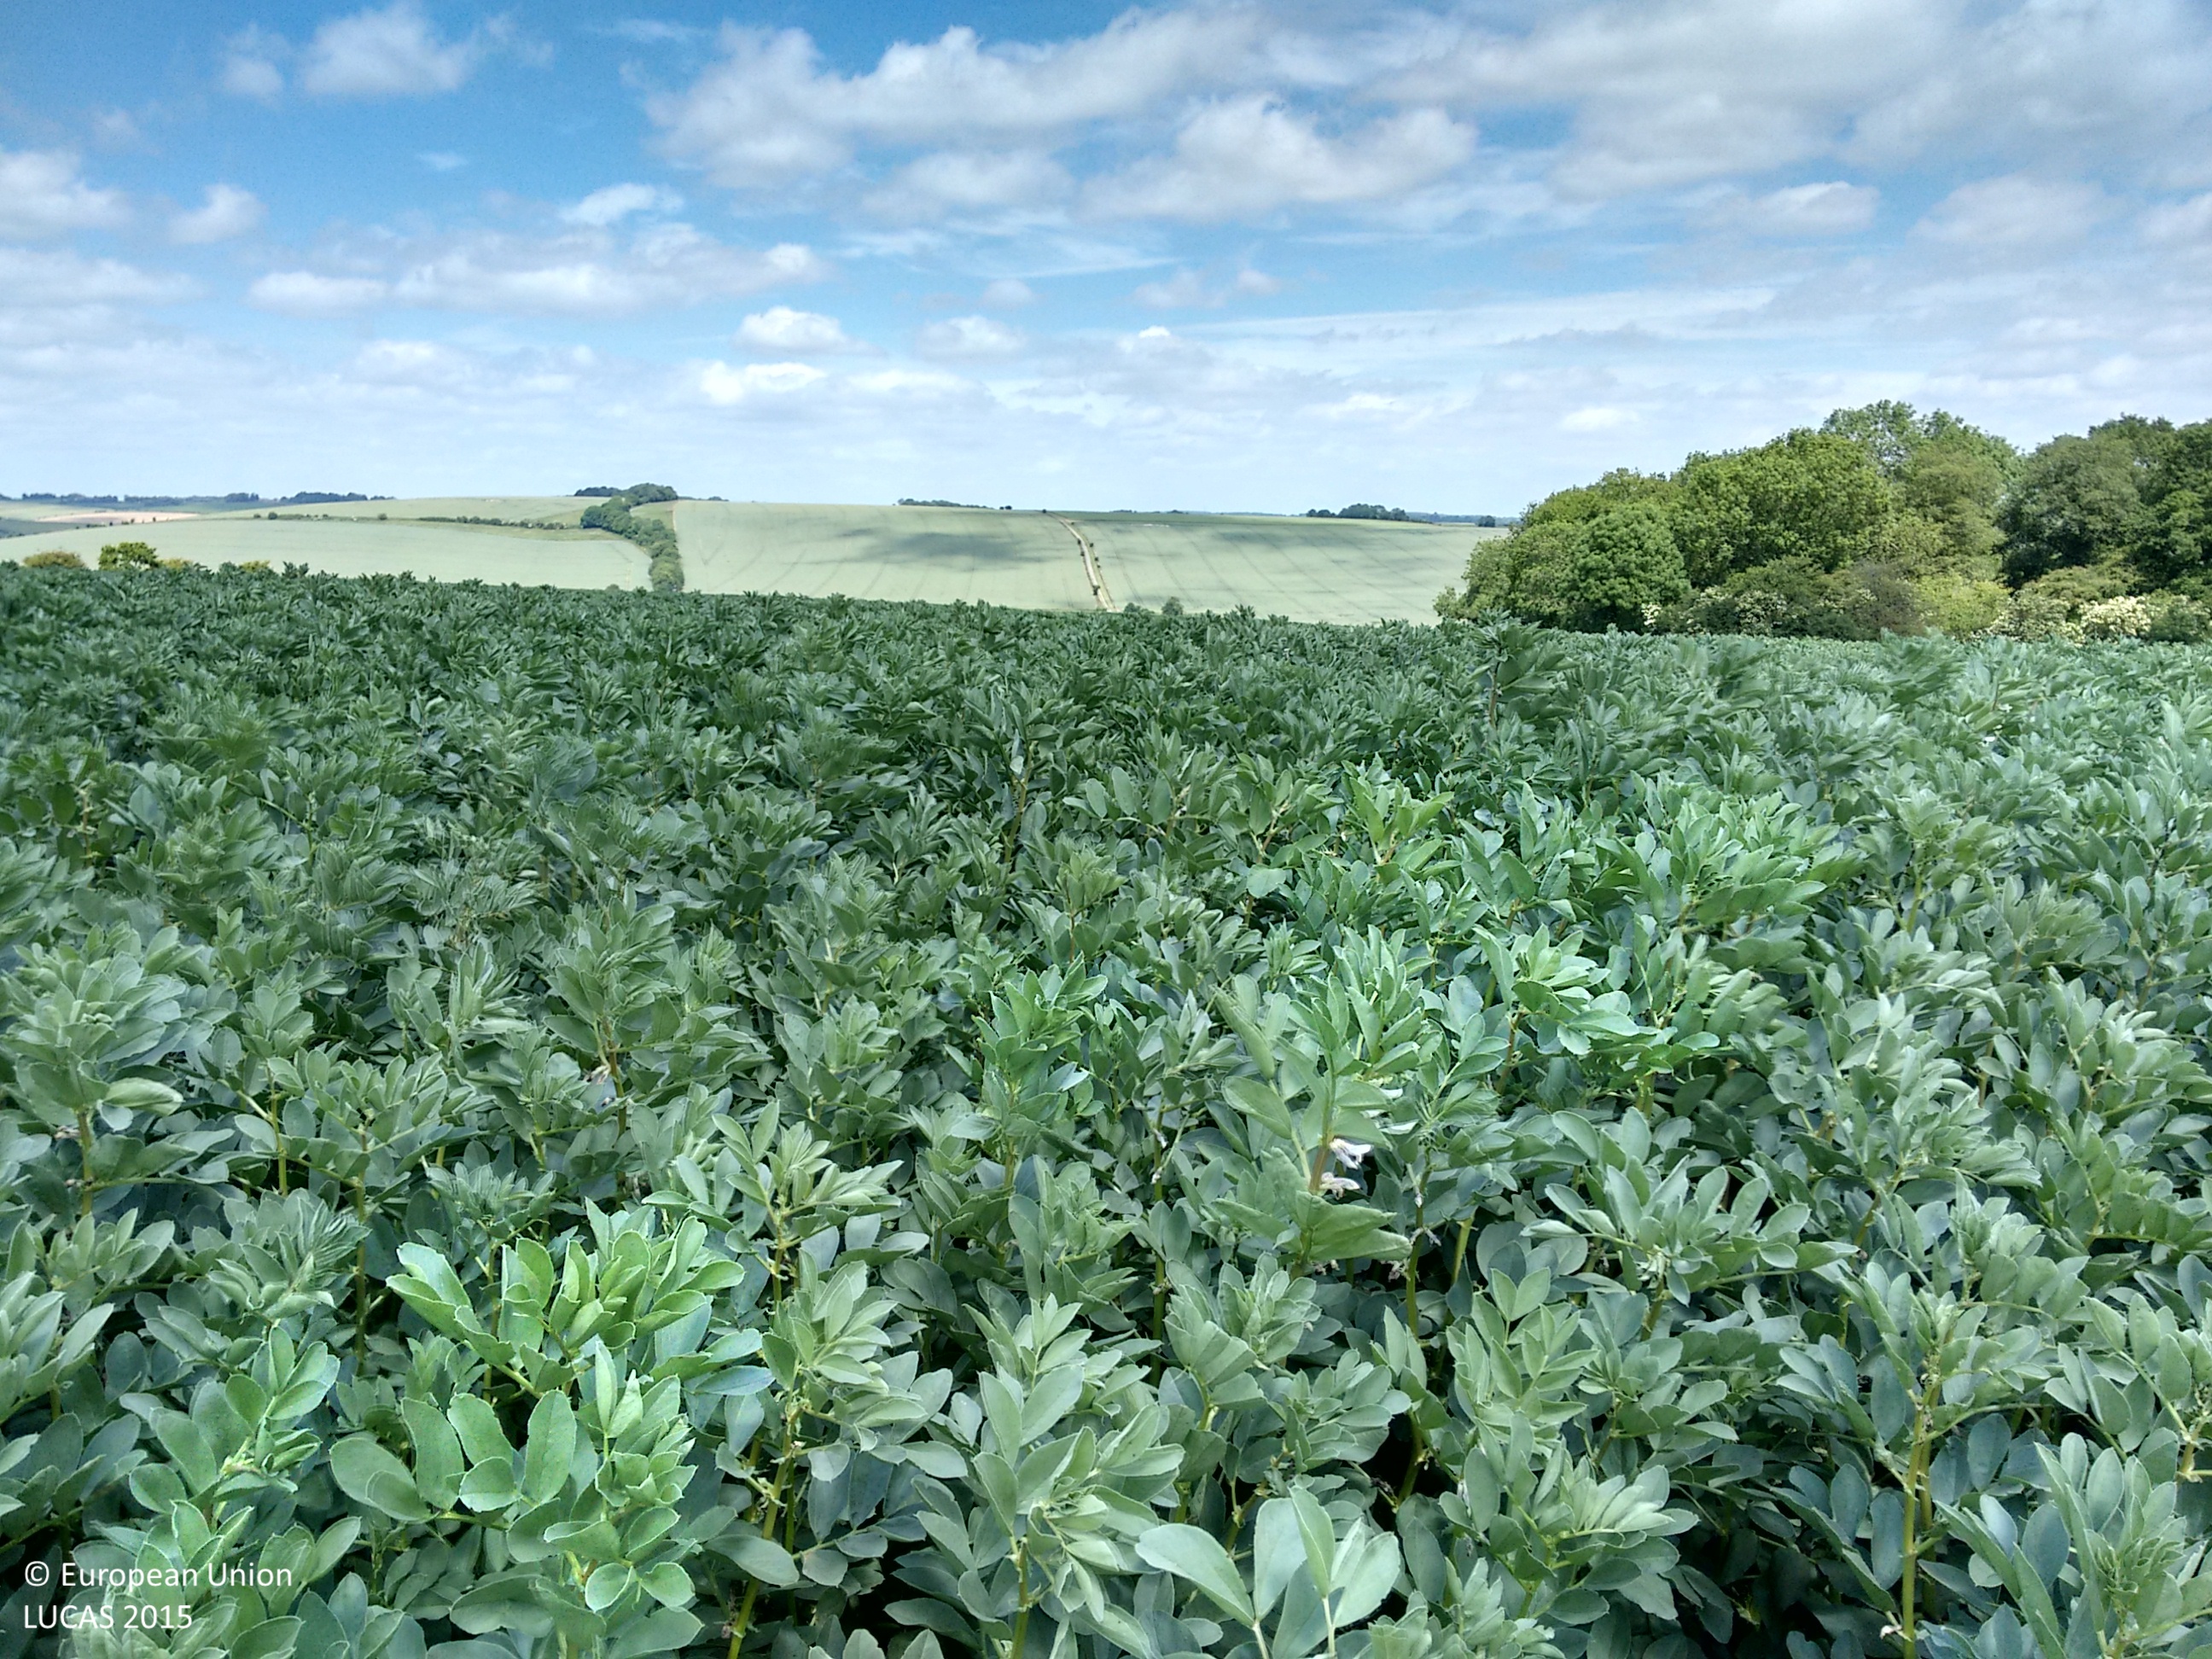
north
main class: Cropland
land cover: Dry pulses
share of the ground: > 75 %
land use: Agriculture (excluding fallow land and kitchen gardens)
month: June
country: GB
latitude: 51.4744
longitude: -1.4679
